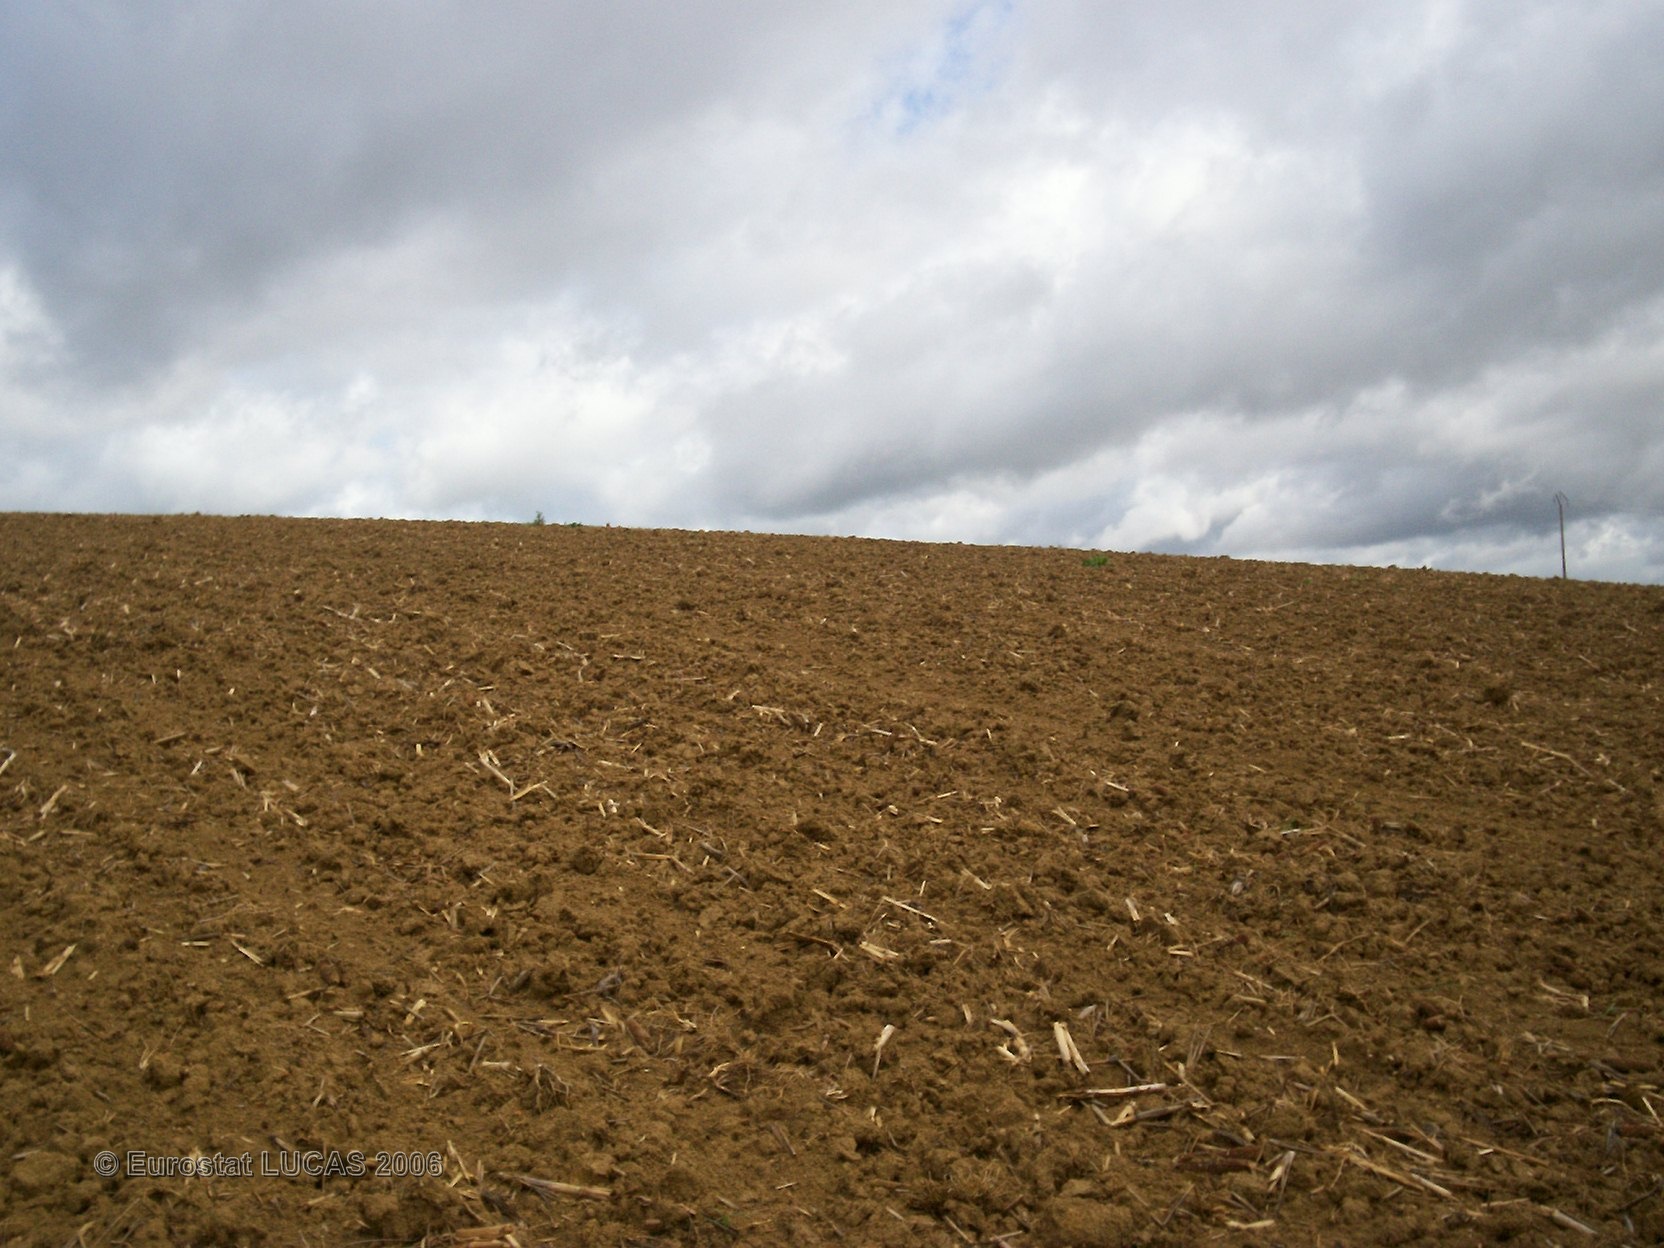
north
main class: Cropland
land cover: Maize
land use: Agriculture (excluding fallow land and kitchen gardens)
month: May
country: FR
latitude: 44.3677
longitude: 0.1143
